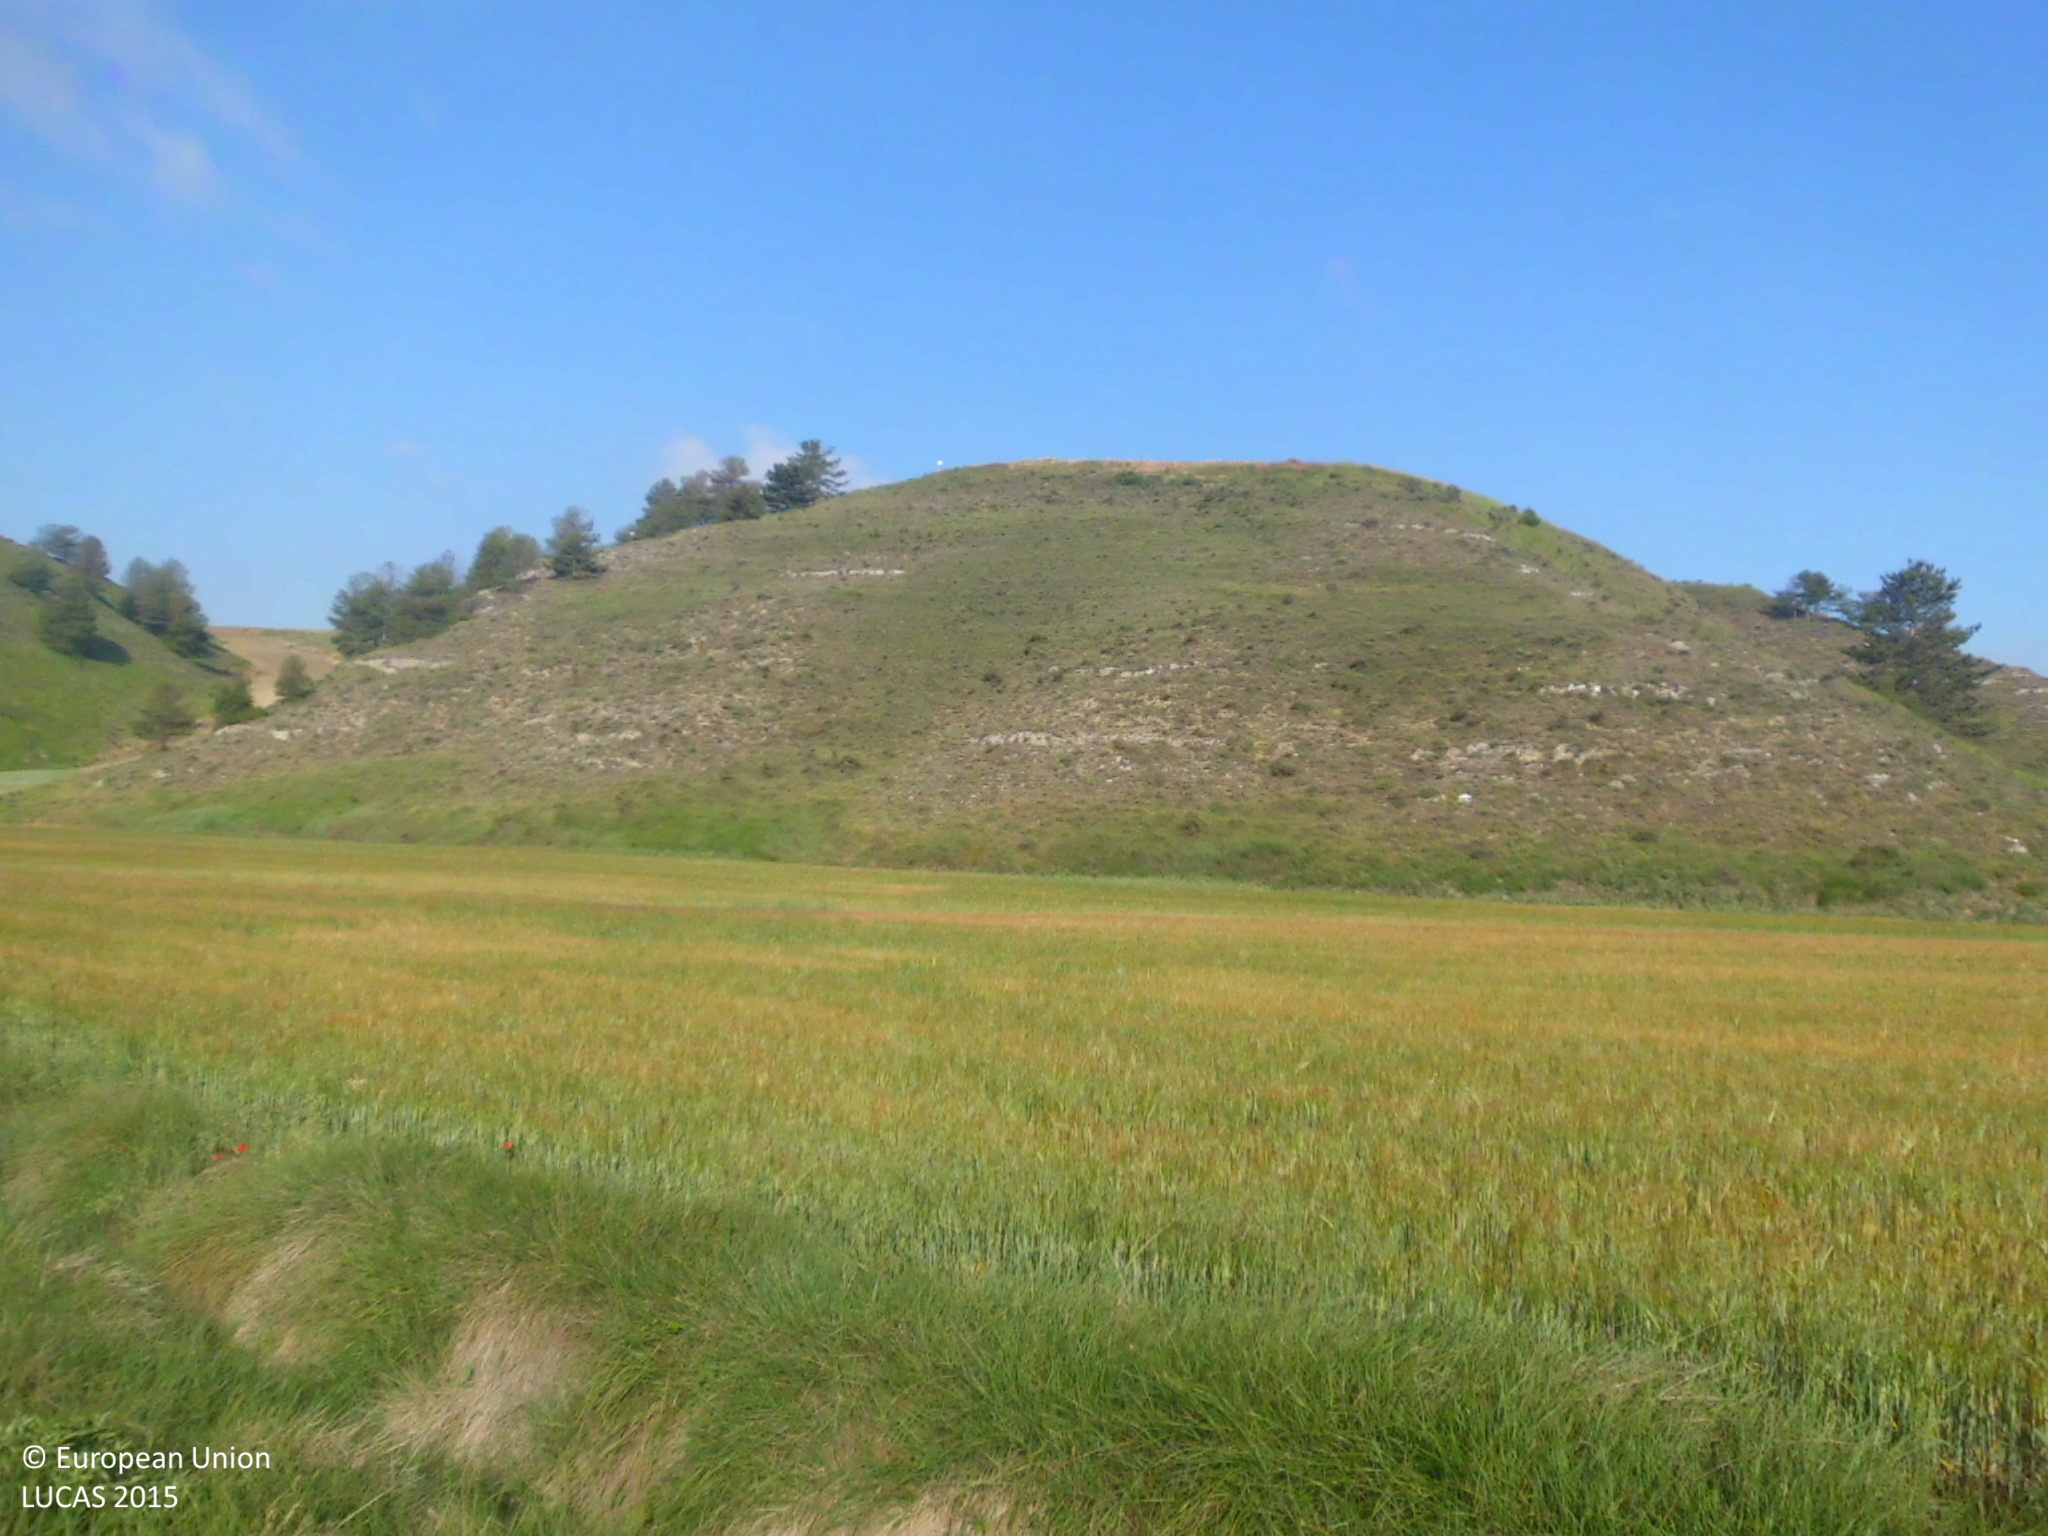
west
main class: Grassland
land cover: Grassland without tree/shrub cover
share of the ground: > 75 %
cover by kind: herbaceous plants 100 %
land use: Abandoned areas
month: June
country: ES
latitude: 42.5266
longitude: -3.2646
